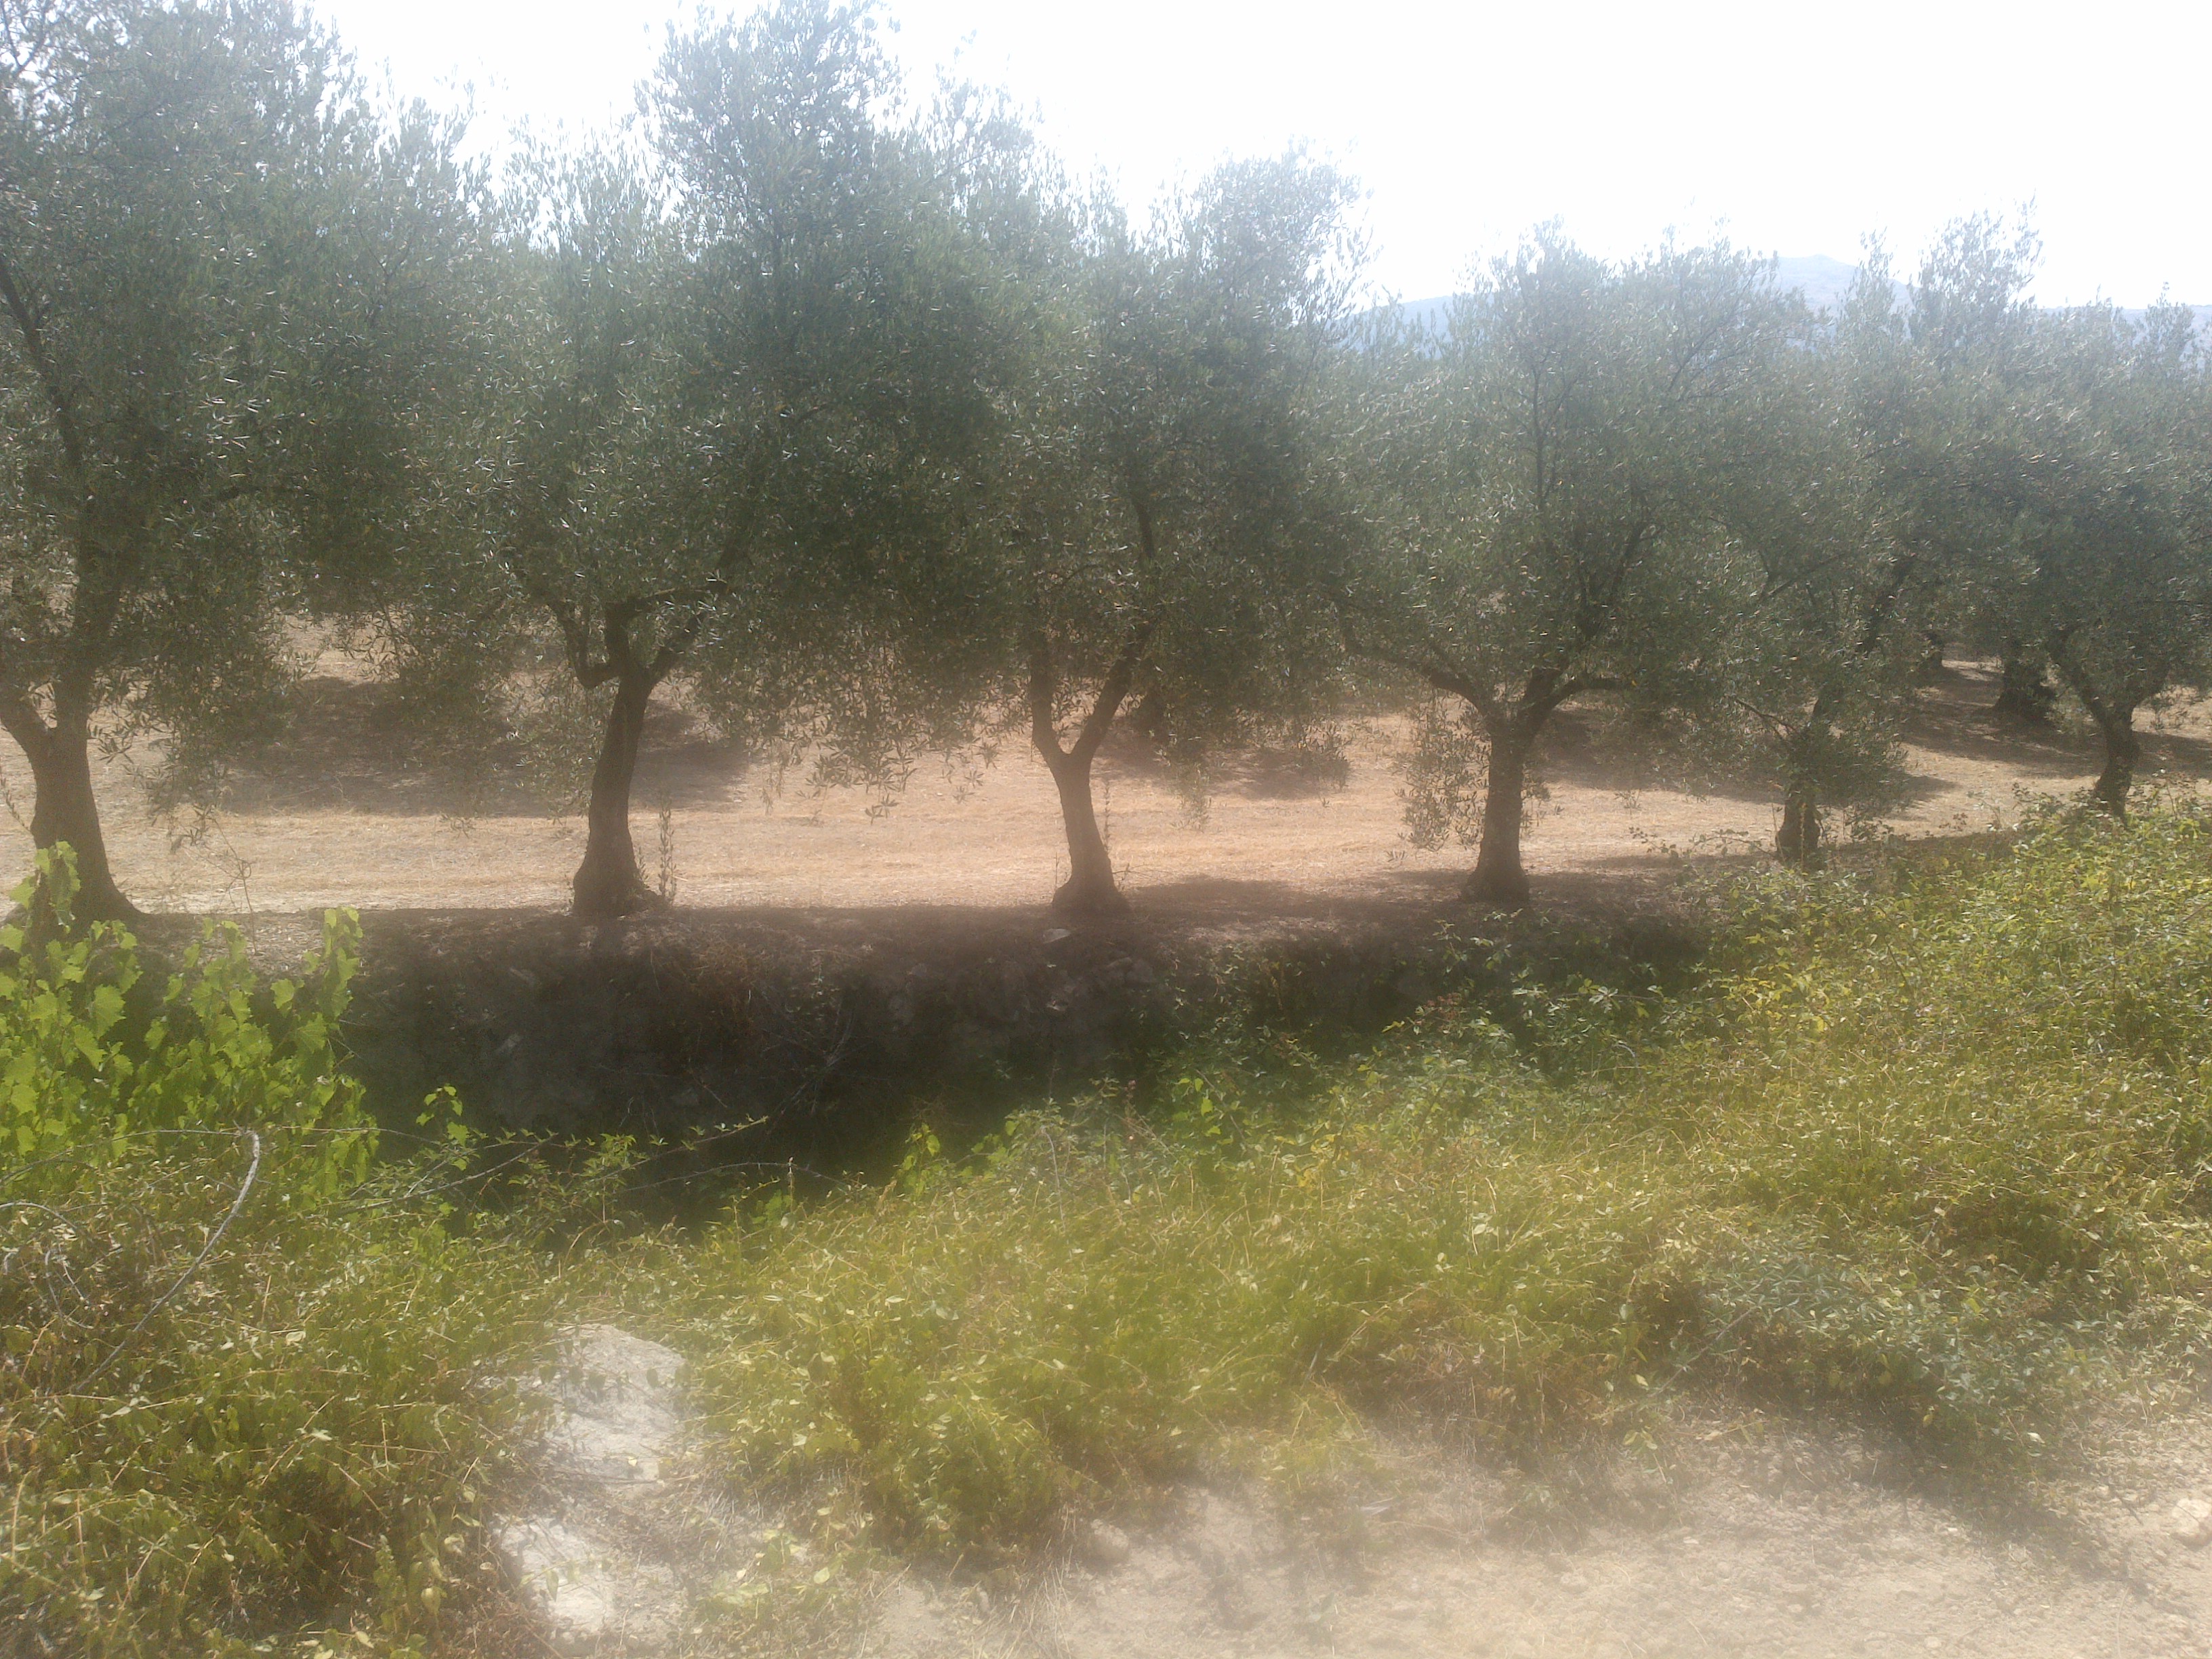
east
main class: Cropland
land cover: Olive groves
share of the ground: 50 - 75 %
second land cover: Other bare soil
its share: > 75 %
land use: Agriculture (excluding fallow land and kitchen gardens)
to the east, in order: Olive groves; Other bare soil; Grass margins; Abandoned hedges; Rivers and streams; Olive groves
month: July
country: ES
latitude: 37.5409
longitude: -4.4343
